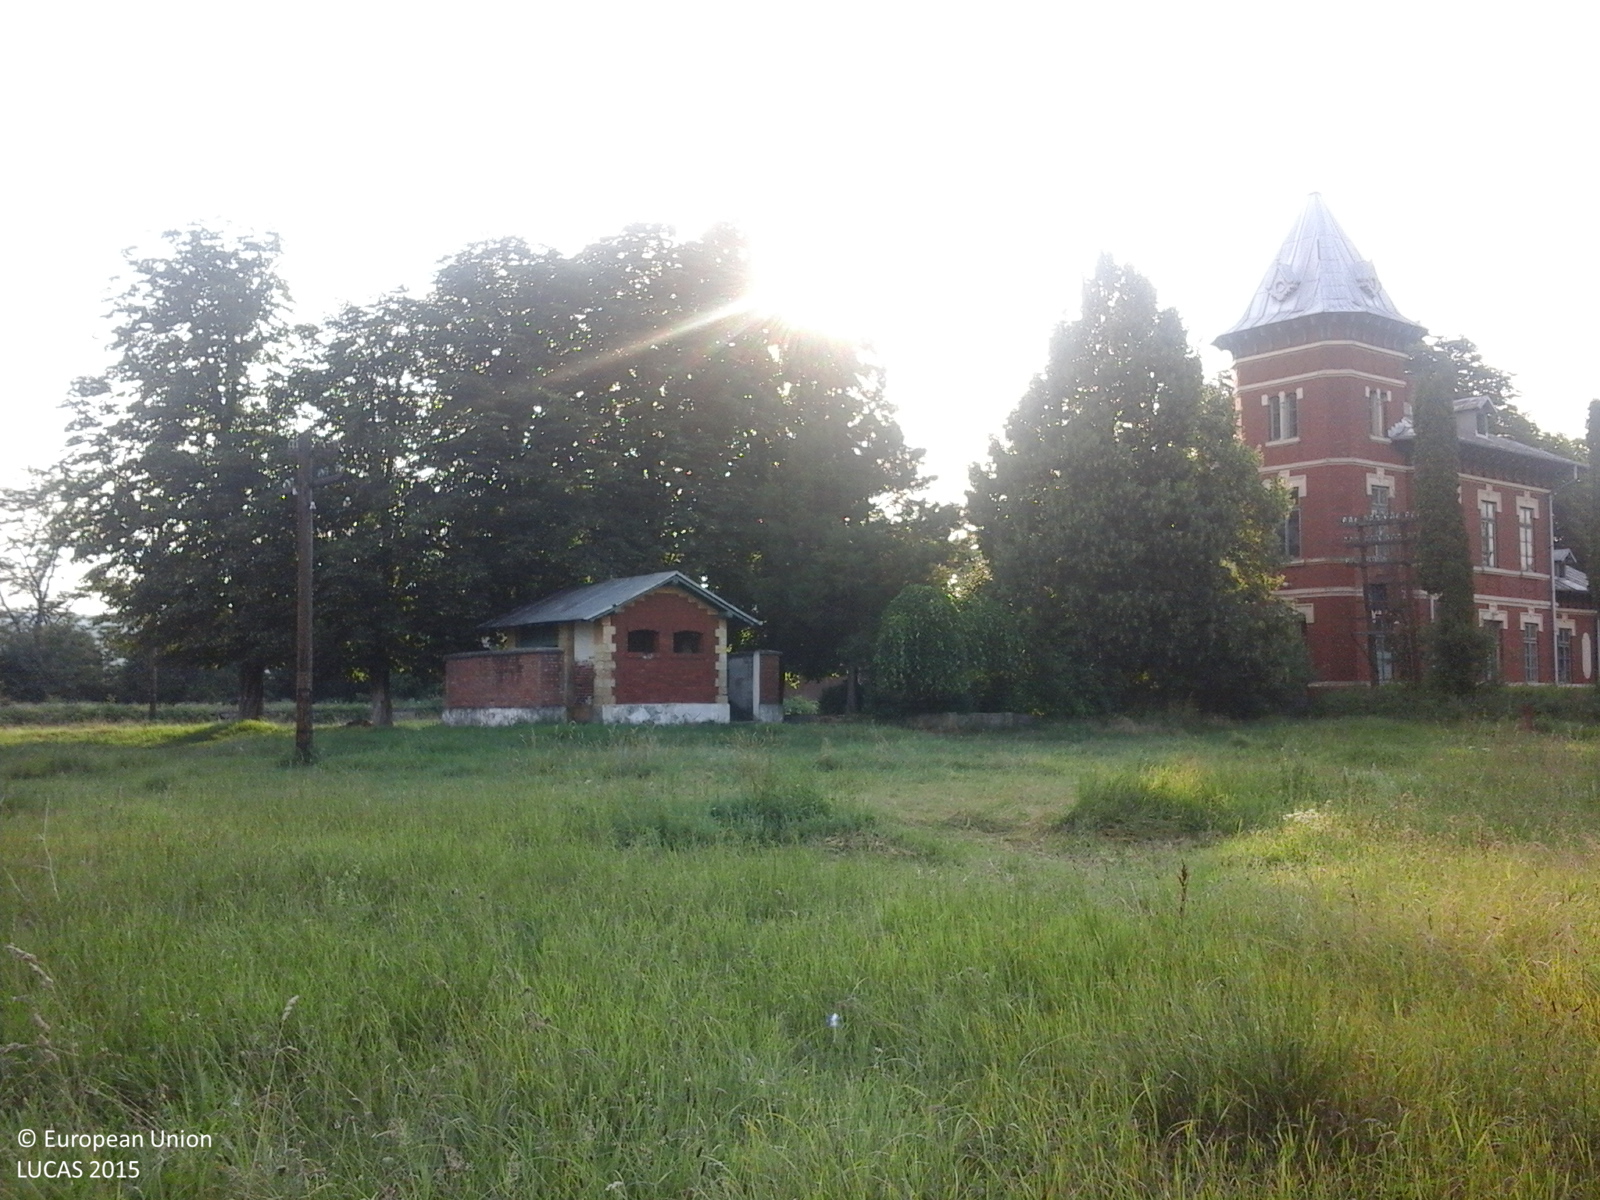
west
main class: Grassland
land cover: Grassland without tree/shrub cover
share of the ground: > 75 %
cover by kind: herbaceous plants 100 %
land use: Agriculture (excluding fallow land and kitchen gardens)
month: July
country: RO
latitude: 45.0549
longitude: 24.6952
